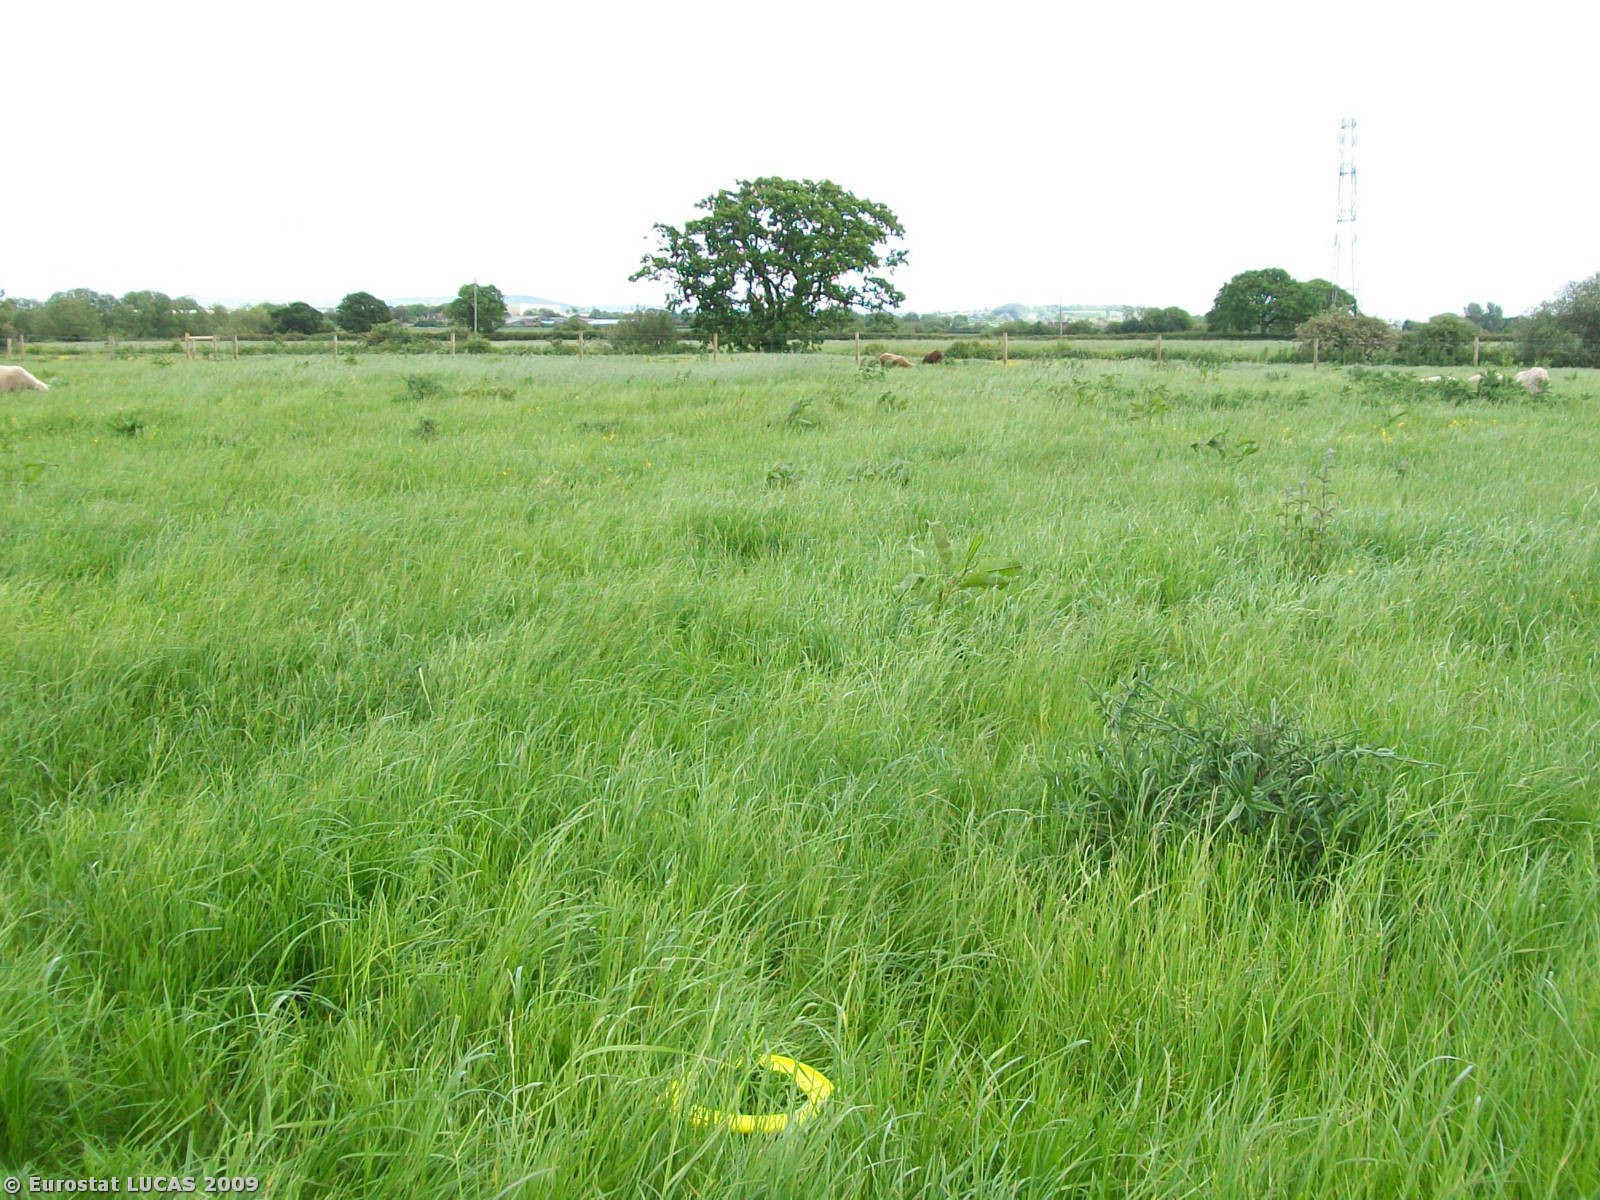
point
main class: Grassland
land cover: Grassland without tree/shrub cover
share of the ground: > 75 %
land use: Agriculture (excluding fallow land and kitchen gardens)
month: May
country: GB
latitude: 51.3488
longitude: -2.1648
